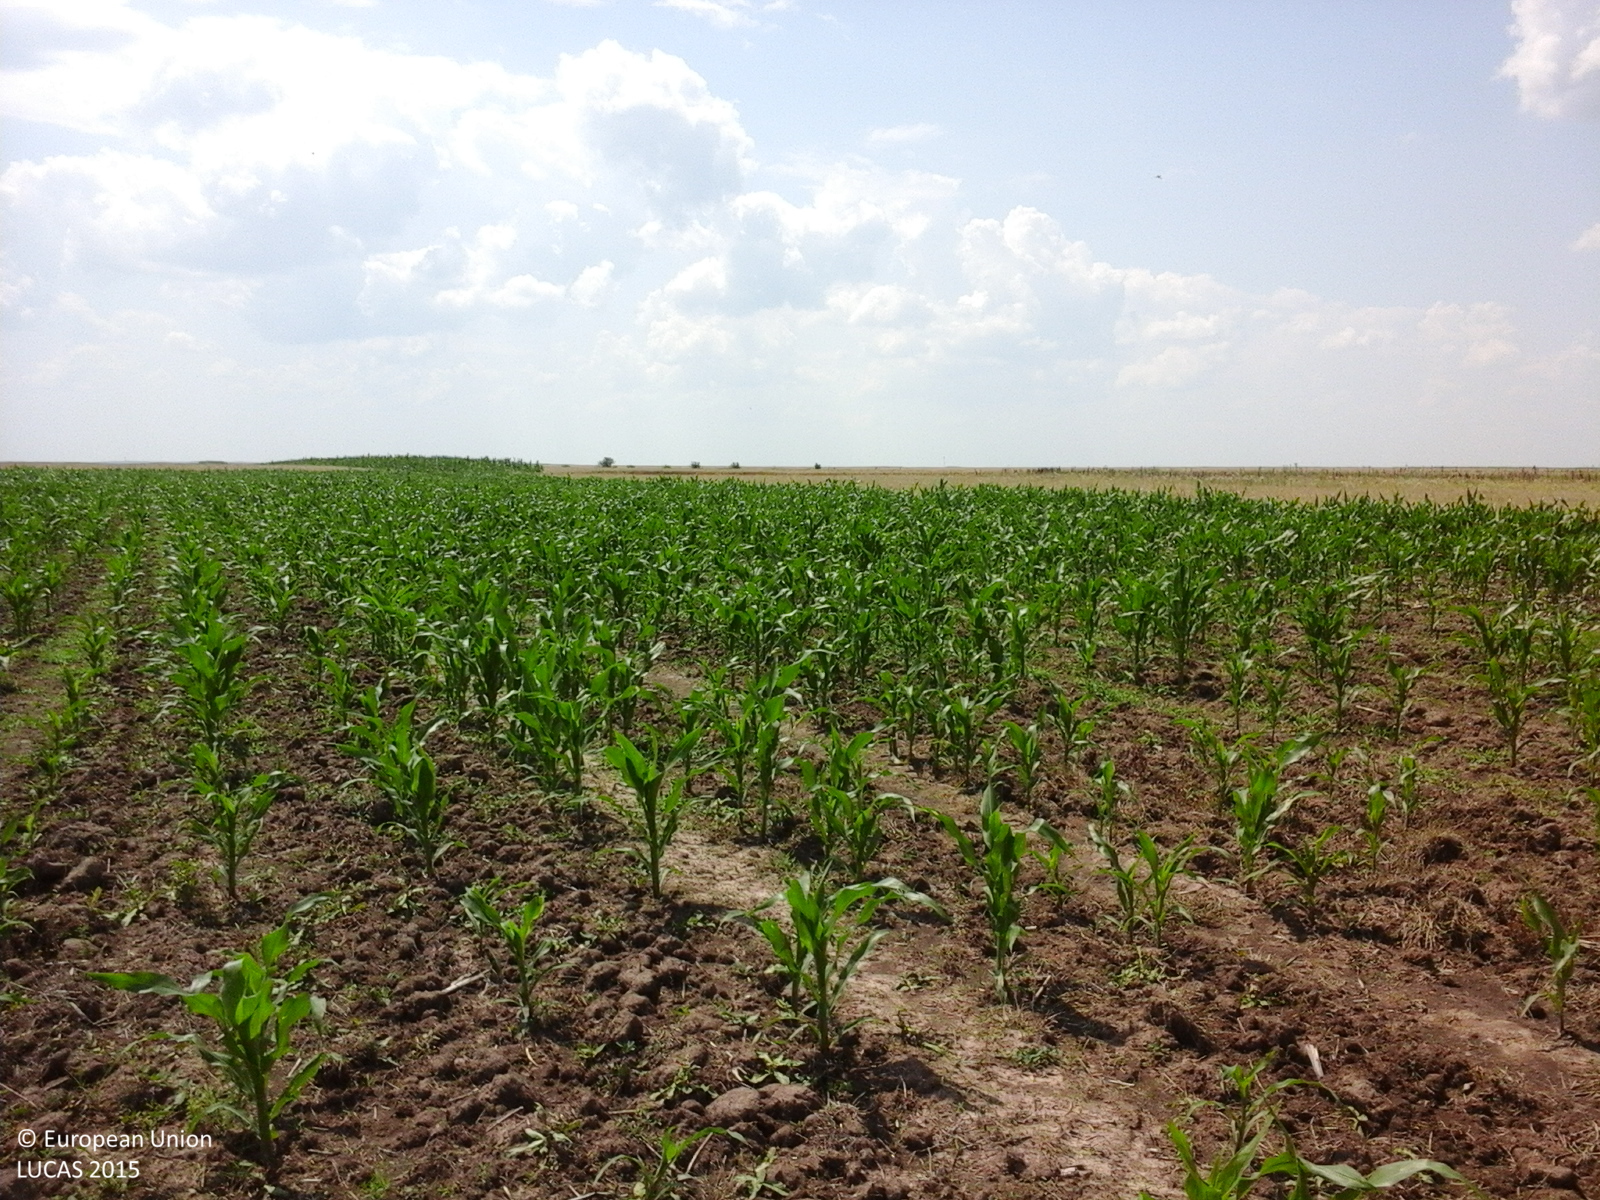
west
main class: Cropland
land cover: Maize
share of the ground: 25 - 50 %
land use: Agriculture (excluding fallow land and kitchen gardens)
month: July
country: RO
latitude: 44.0339
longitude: 25.2934
